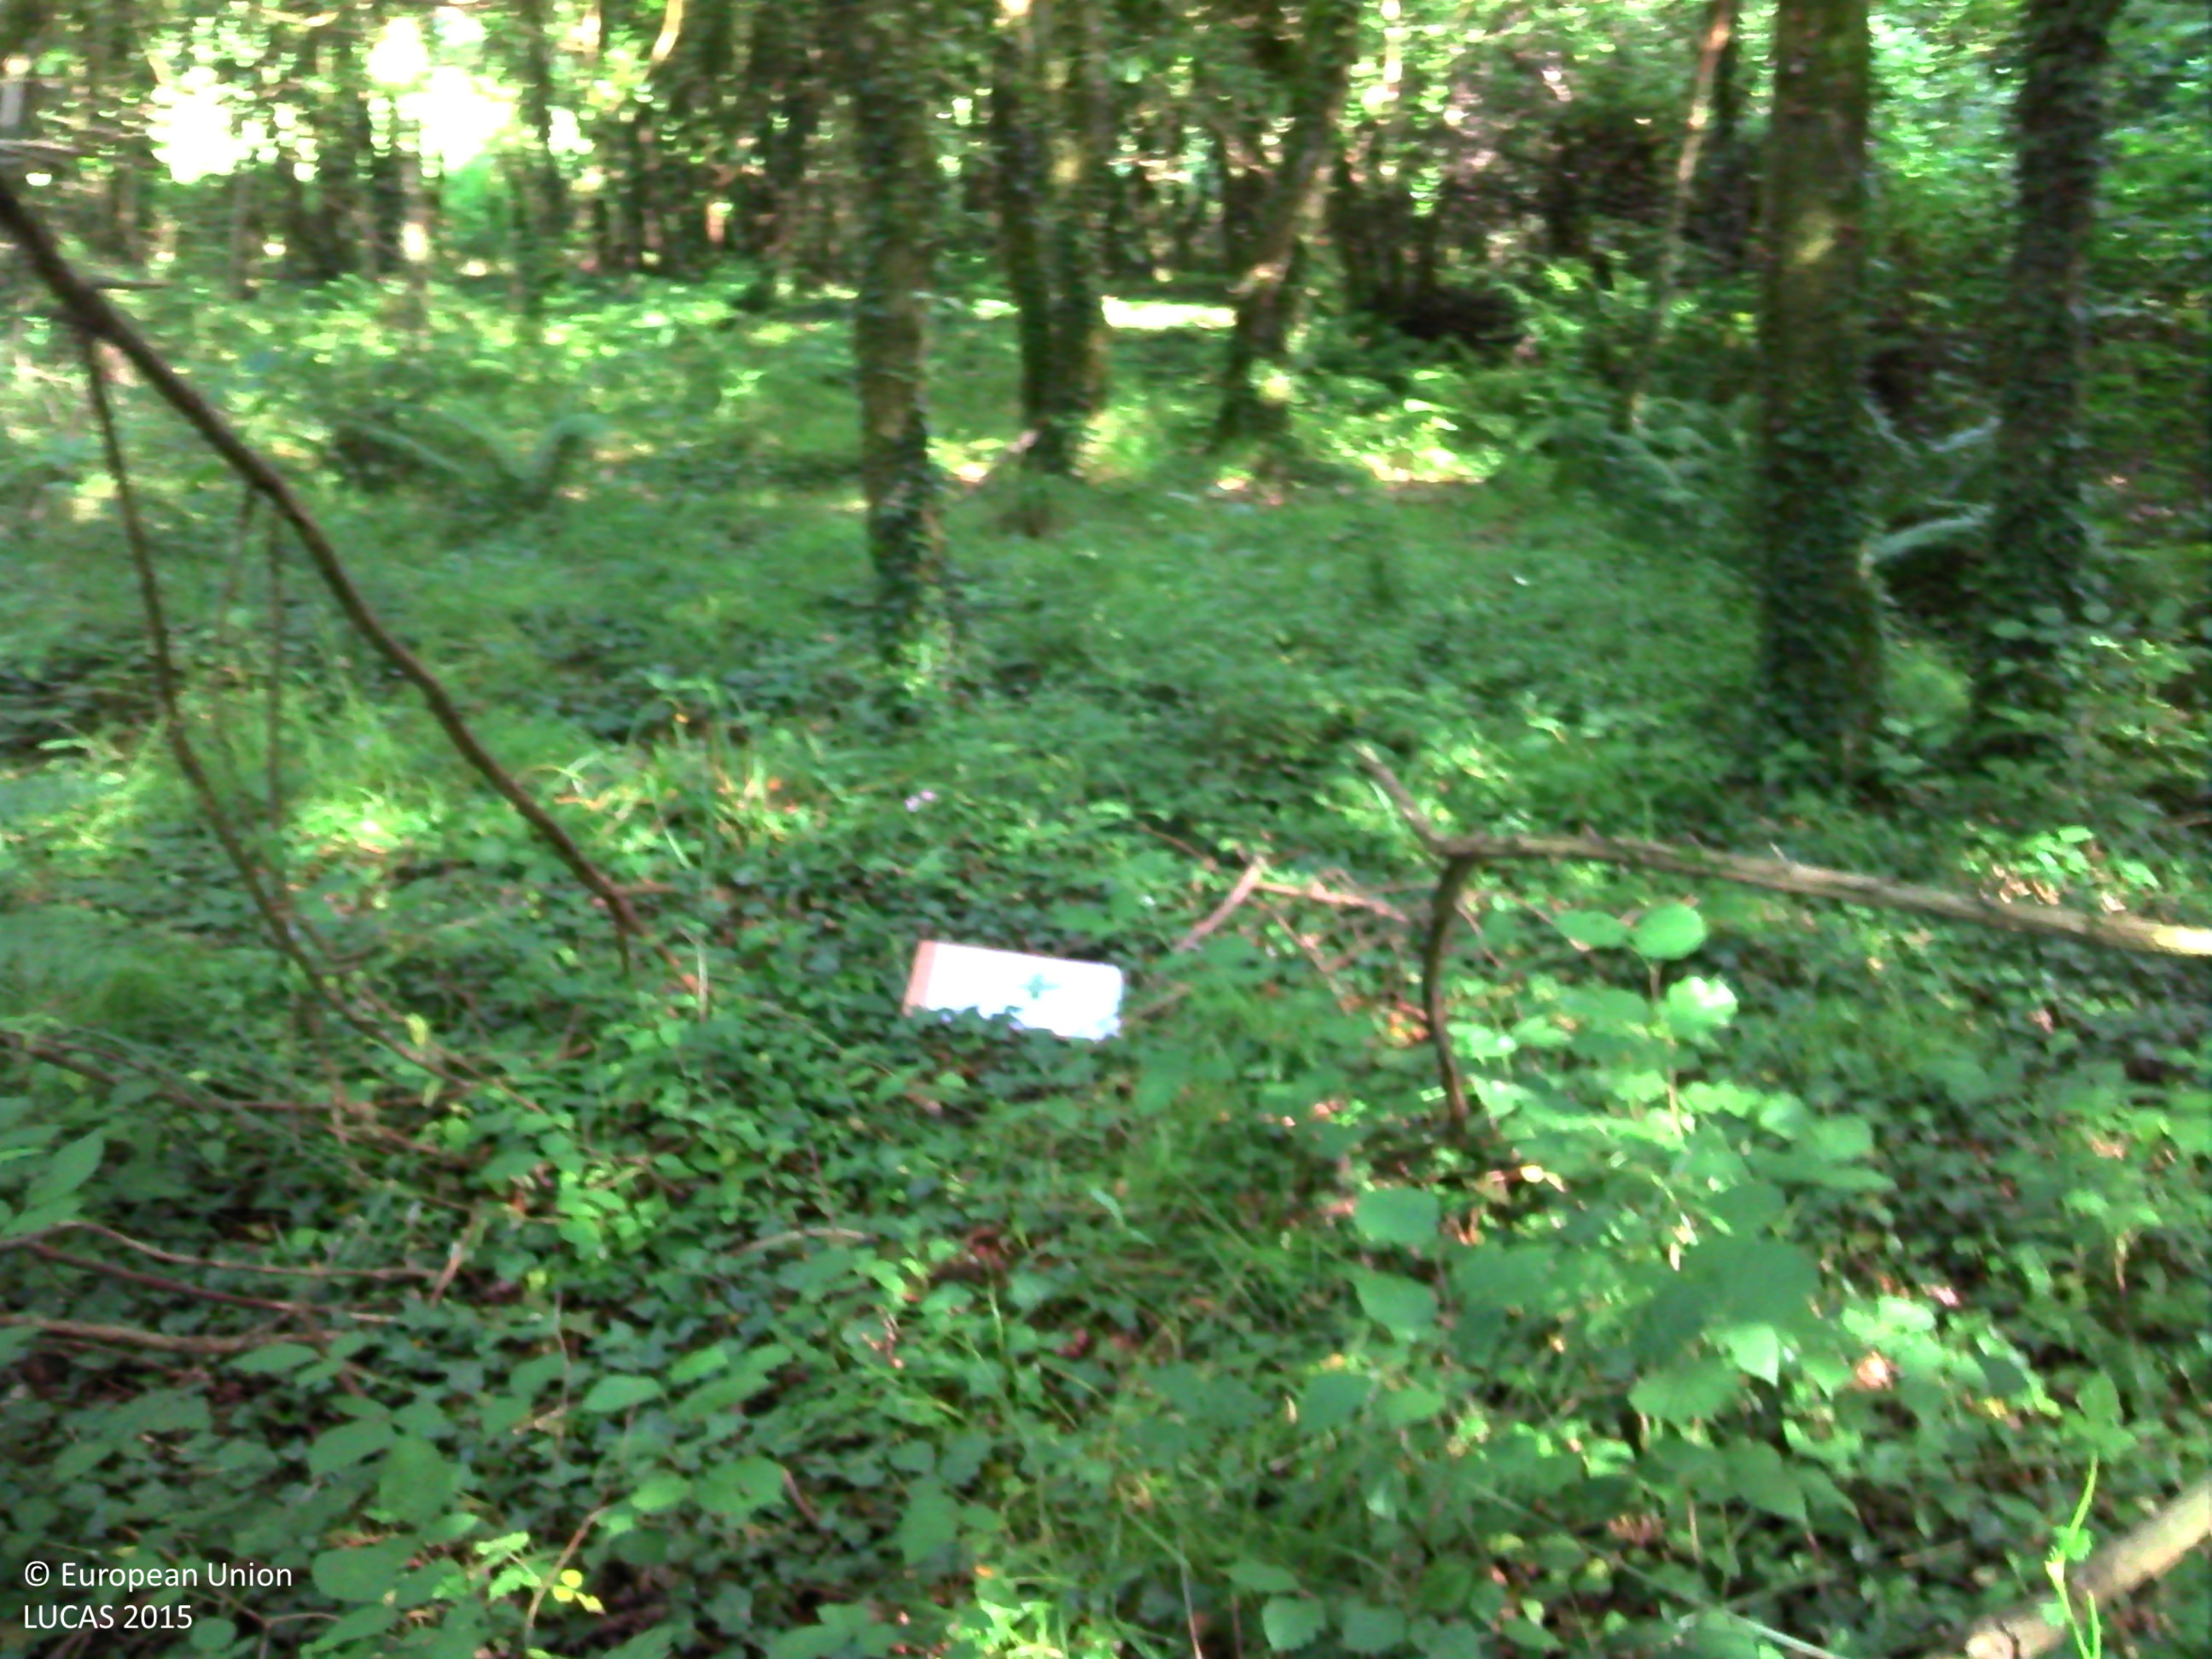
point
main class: Woodland
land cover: Broadleaved woodland
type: acidophilous oak and oak-birch forest
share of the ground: > 75 %
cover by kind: broadleaved forest trees 70 %, shrubs 10 %, herbaceous plants 10 %, lichens and mosses 5 %, consolidated bare surface 5 %
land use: Forestry
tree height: > 5 m
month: July
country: FR
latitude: 47.9018
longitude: -3.0303
